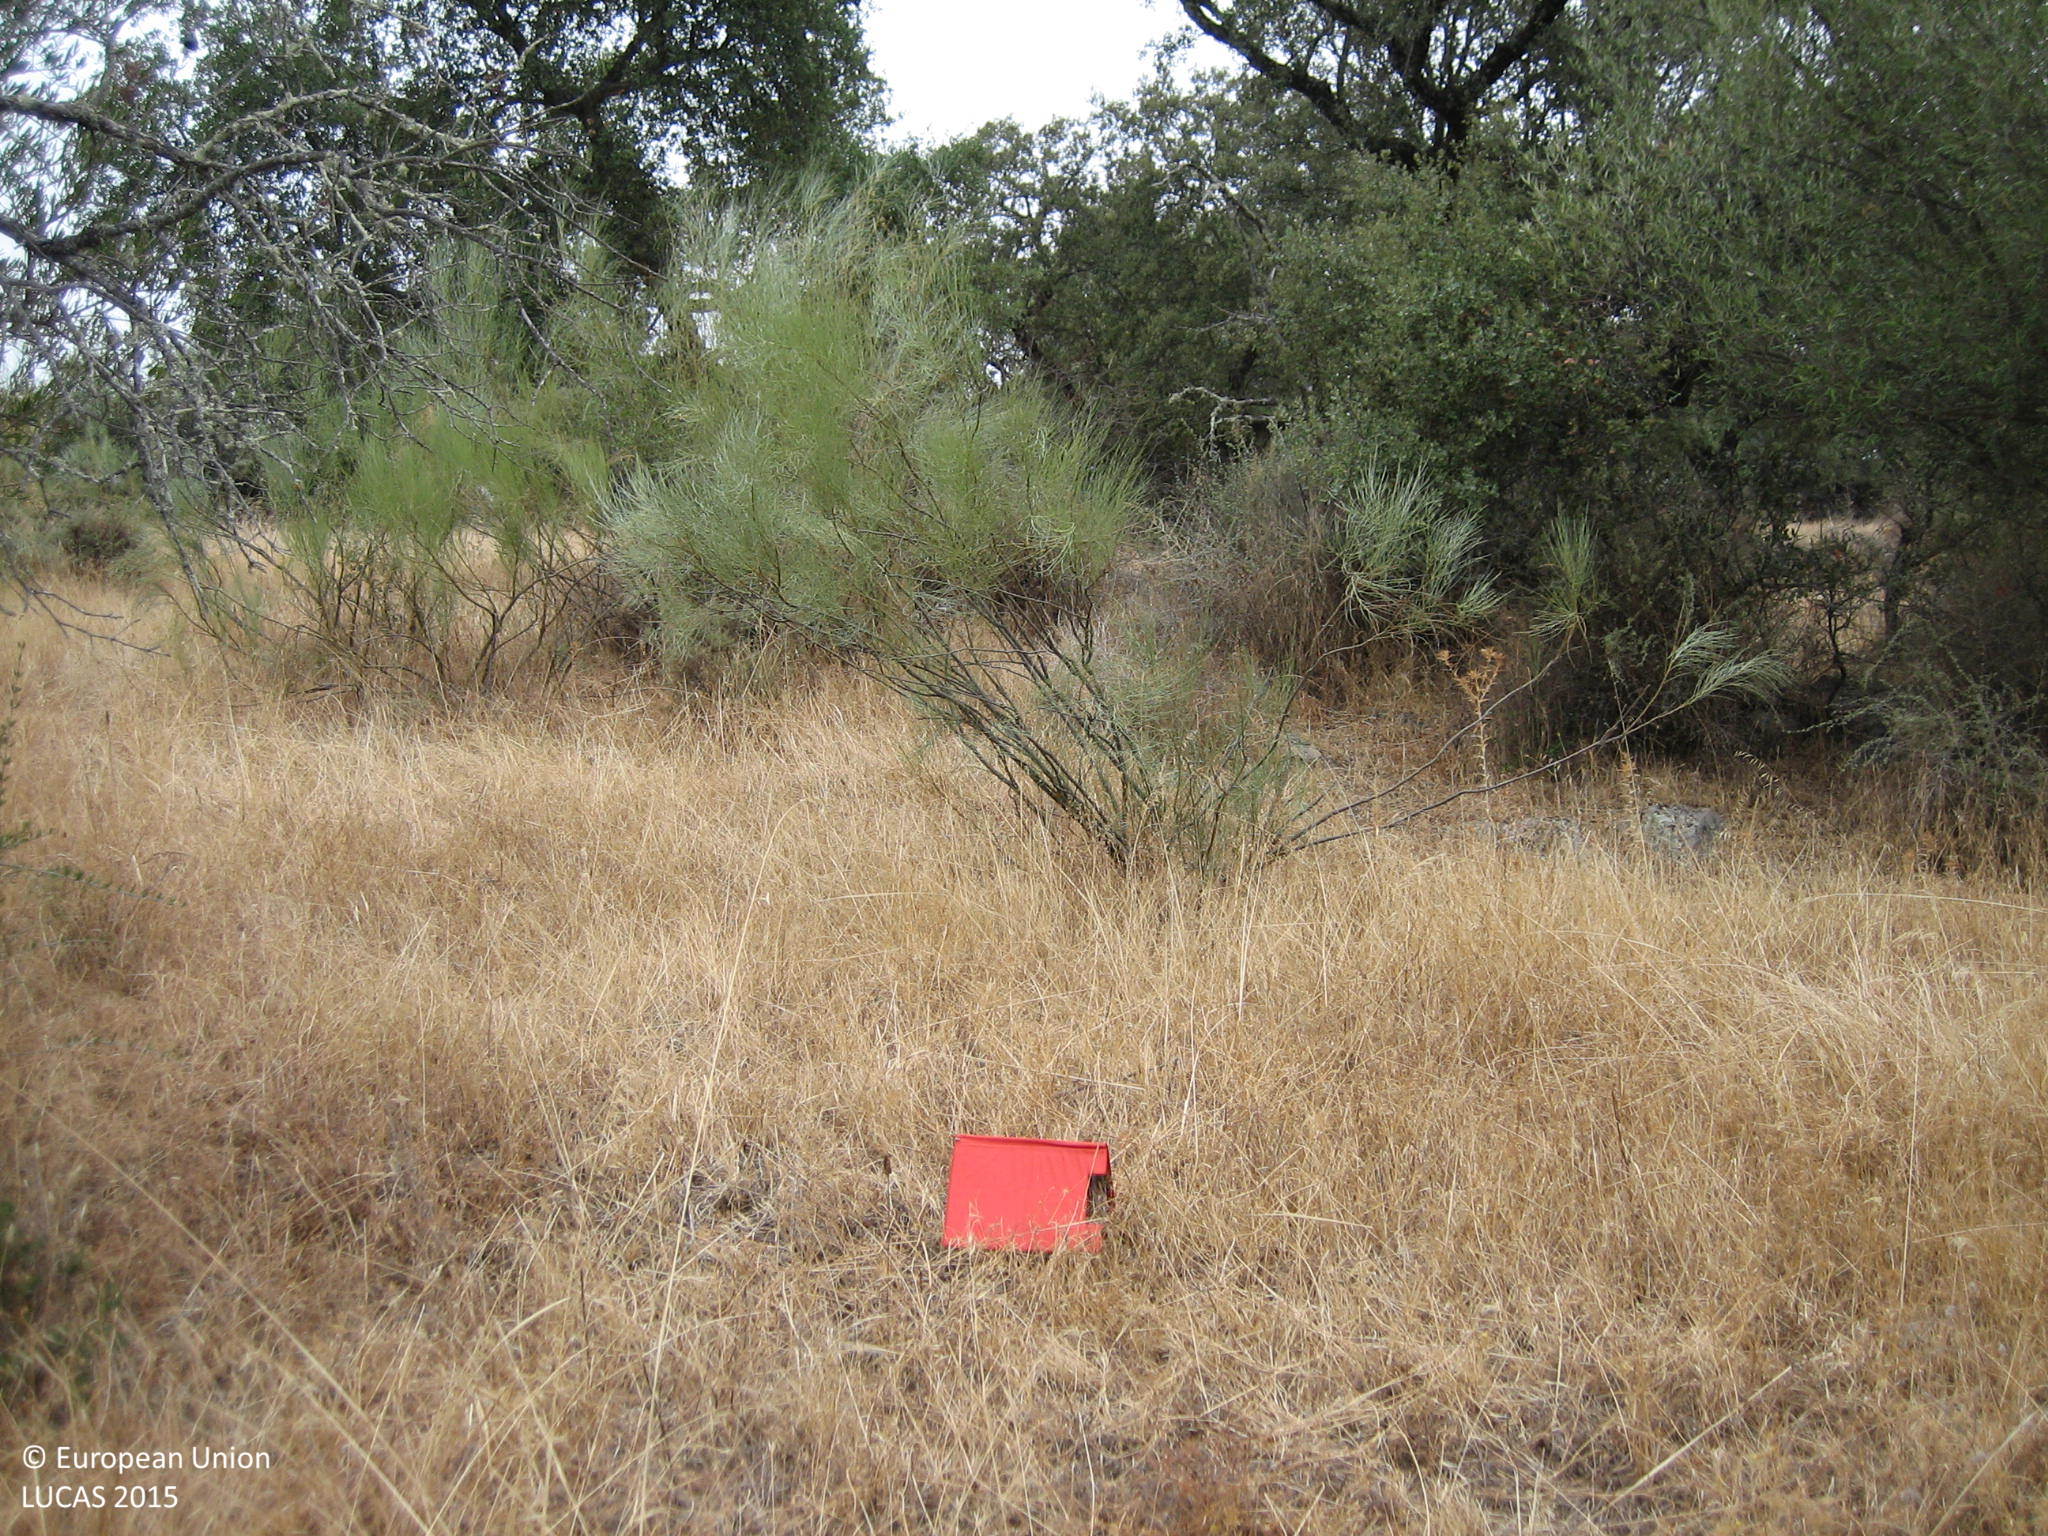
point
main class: Woodland
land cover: Broadleaved woodland
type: broadleaved evergreen forest
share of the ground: 10 - 25 %
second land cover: Shrubland without tree cover
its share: 25 - 50 %
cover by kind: herbaceous plants 55 %, shrubs 30 %, broadleaved forest trees 15 %
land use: Forestry
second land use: Agriculture (excluding fallow land and kitchen gardens)
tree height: > 5 m
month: September
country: ES
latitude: 38.2817
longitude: -6.8497
